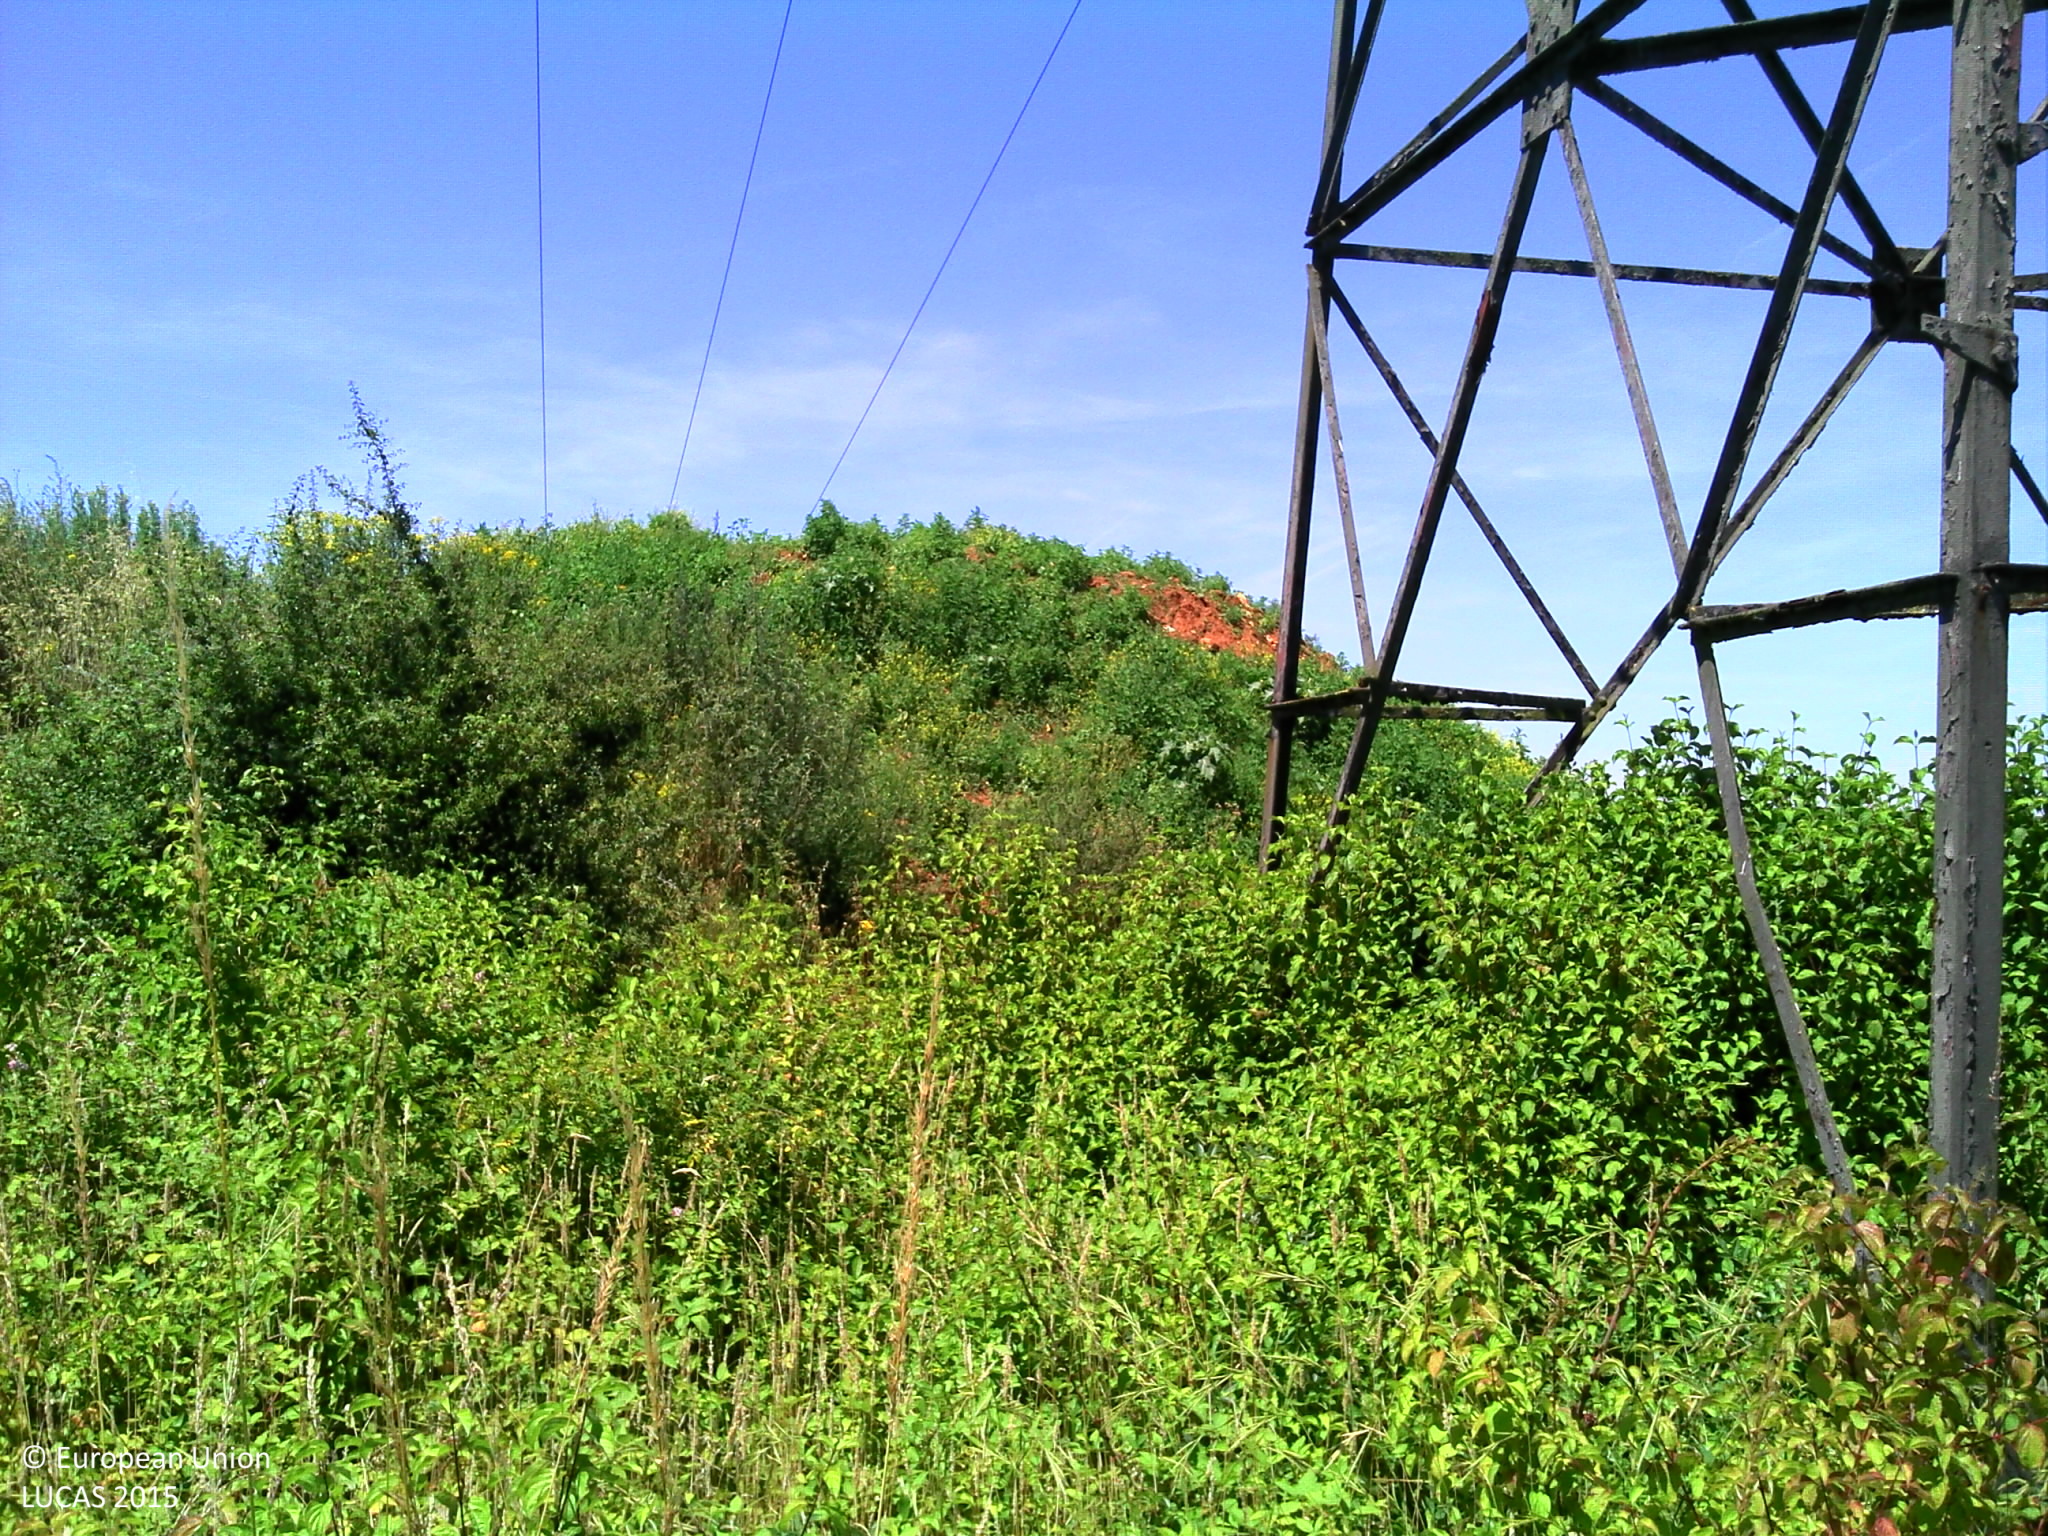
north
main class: Grassland
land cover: Grassland without tree/shrub cover
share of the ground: > 75 %
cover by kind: herbaceous plants 95 %, shrubs 5 %
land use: Mining and quarrying
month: June
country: FR
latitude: 45.8466
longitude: -0.7263
